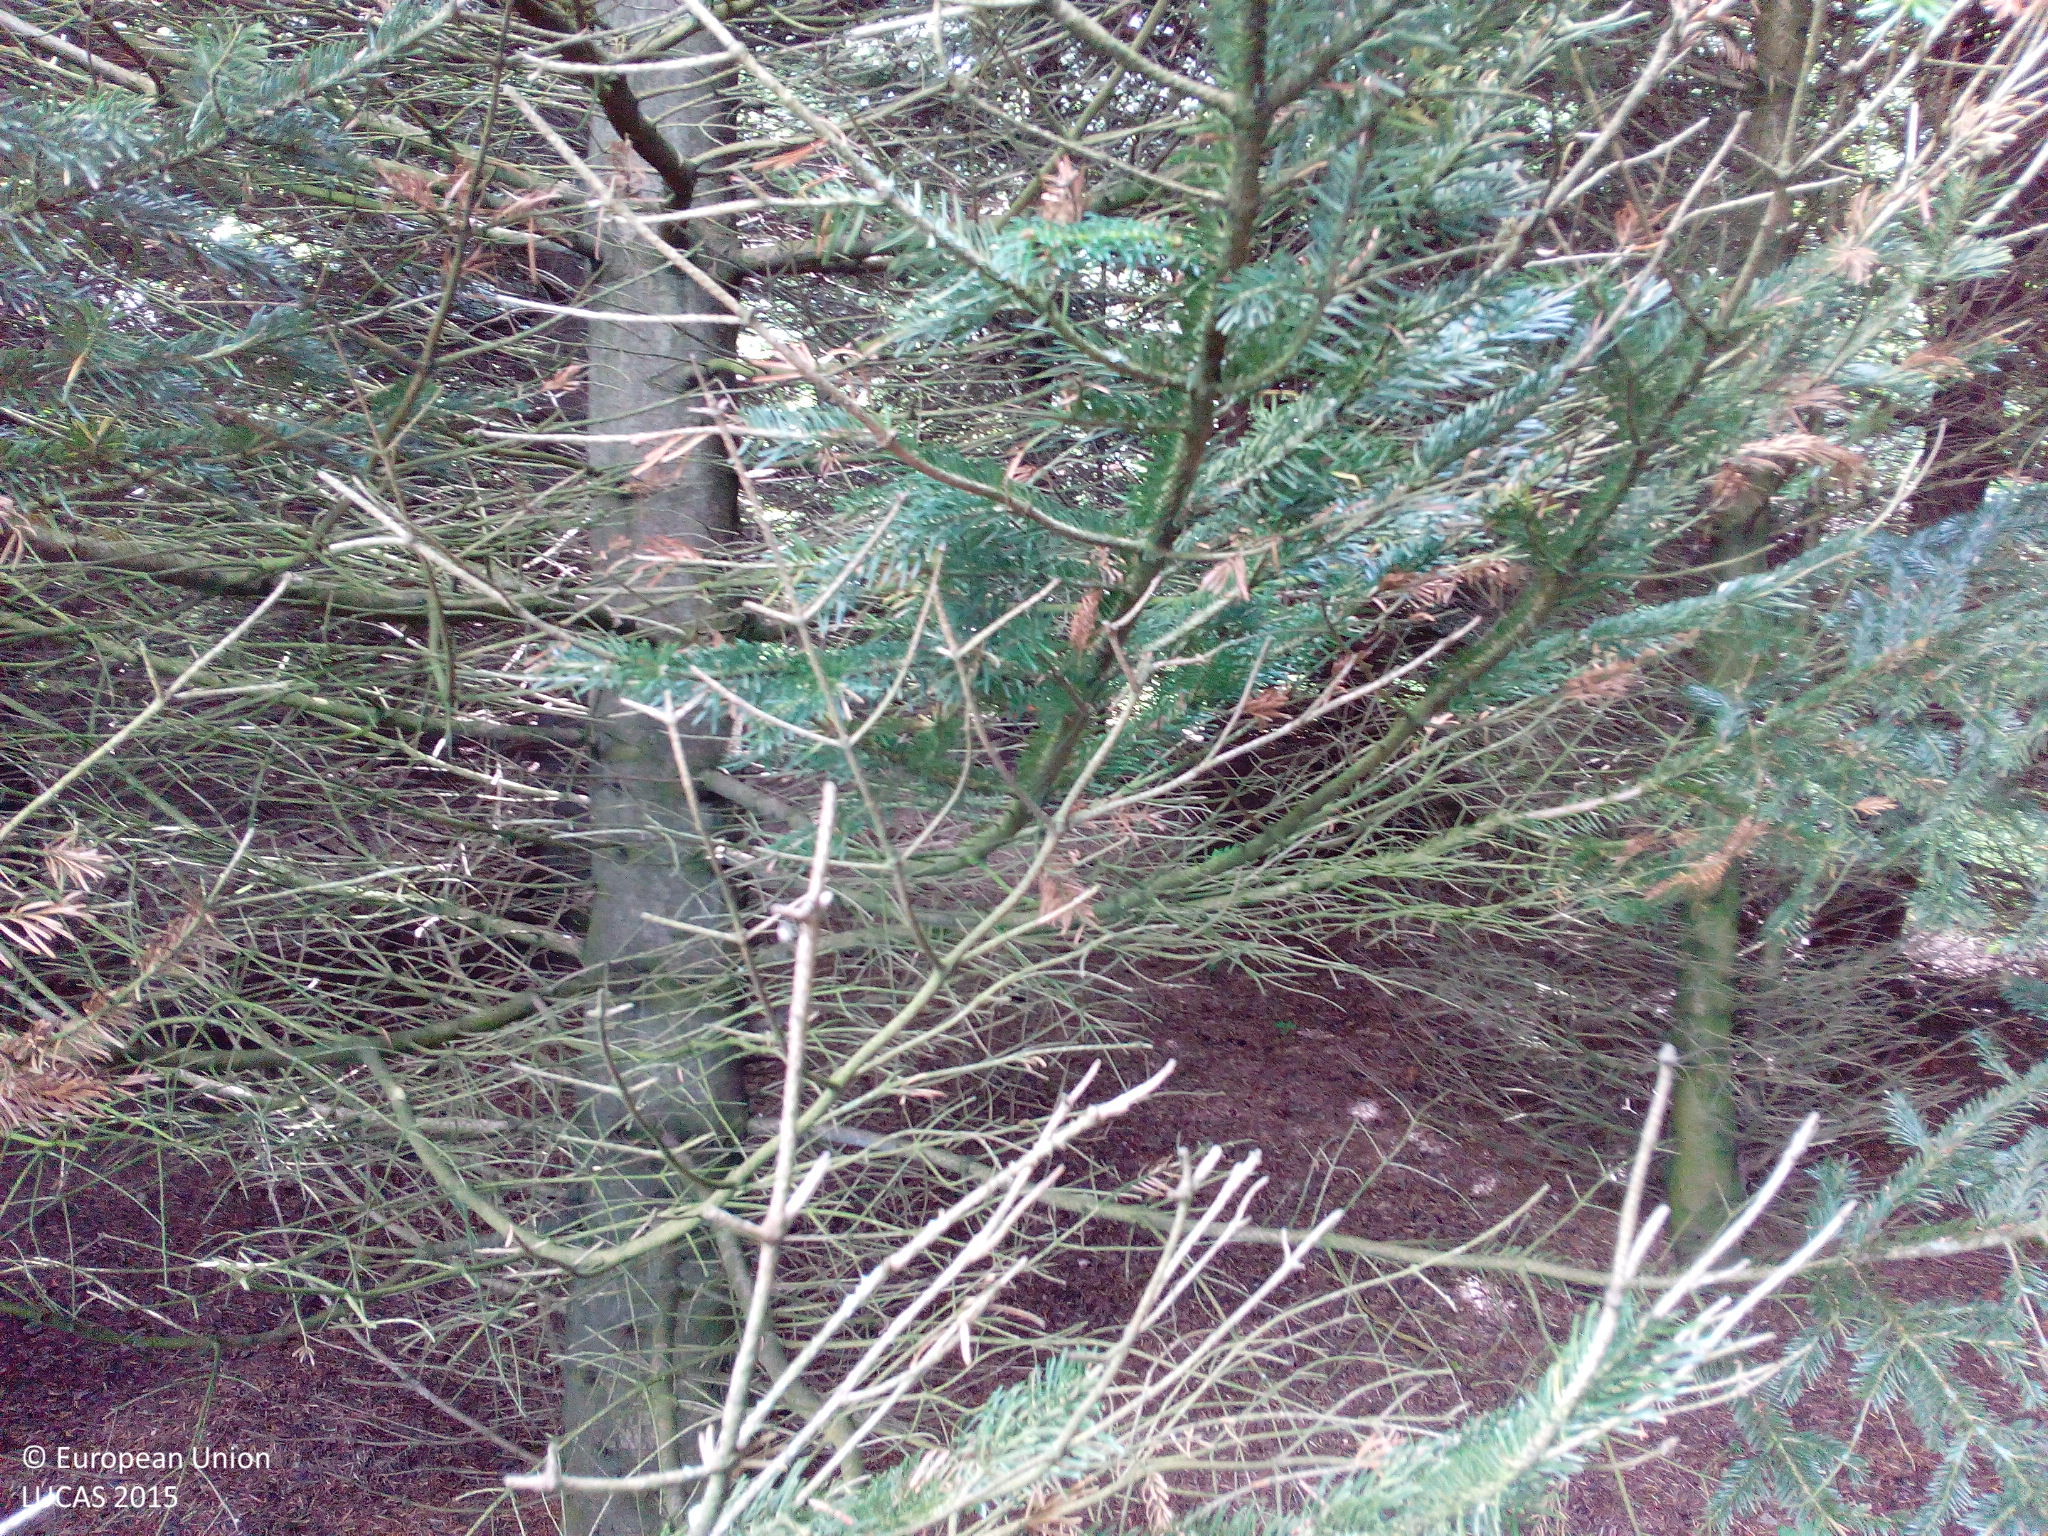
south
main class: Woodland
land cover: Spruce dominated coniferous woodland
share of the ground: > 75 %
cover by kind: coniferous forest trees 80 %, herbaceous plants 20 %
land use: Agriculture (excluding fallow land and kitchen gardens)
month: July
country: DK
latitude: 55.8965
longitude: 12.3487
